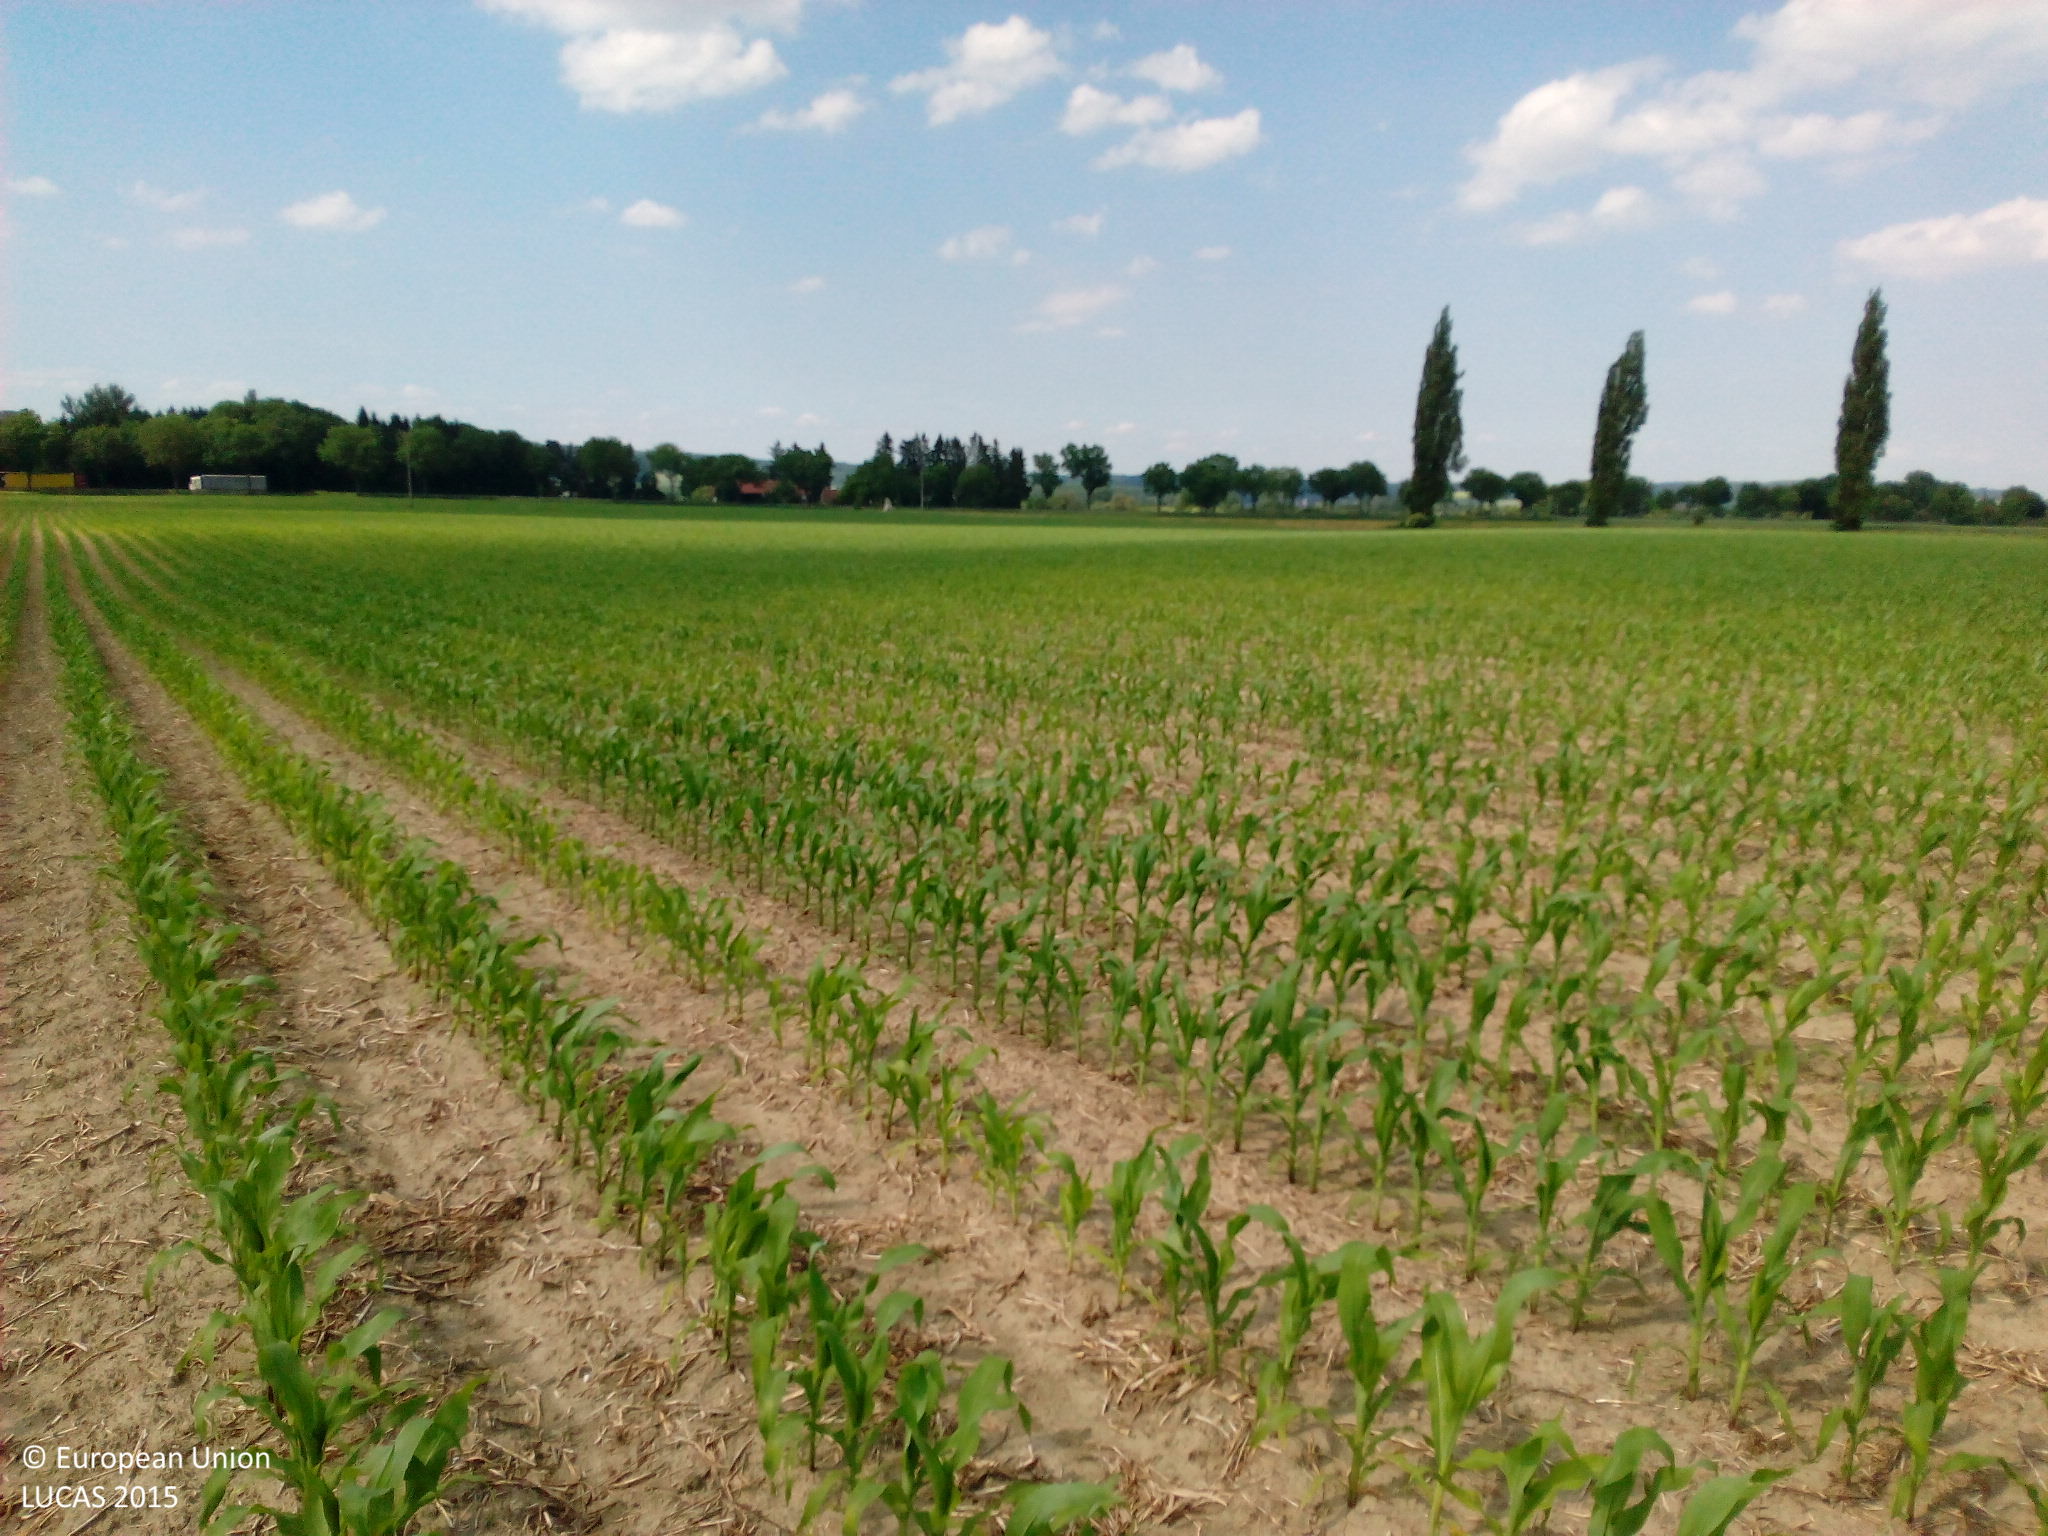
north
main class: Cropland
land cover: Maize
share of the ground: 25 - 50 %
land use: Agriculture (excluding fallow land and kitchen gardens)
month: June
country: DE
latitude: 48.6294
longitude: 12.4008
